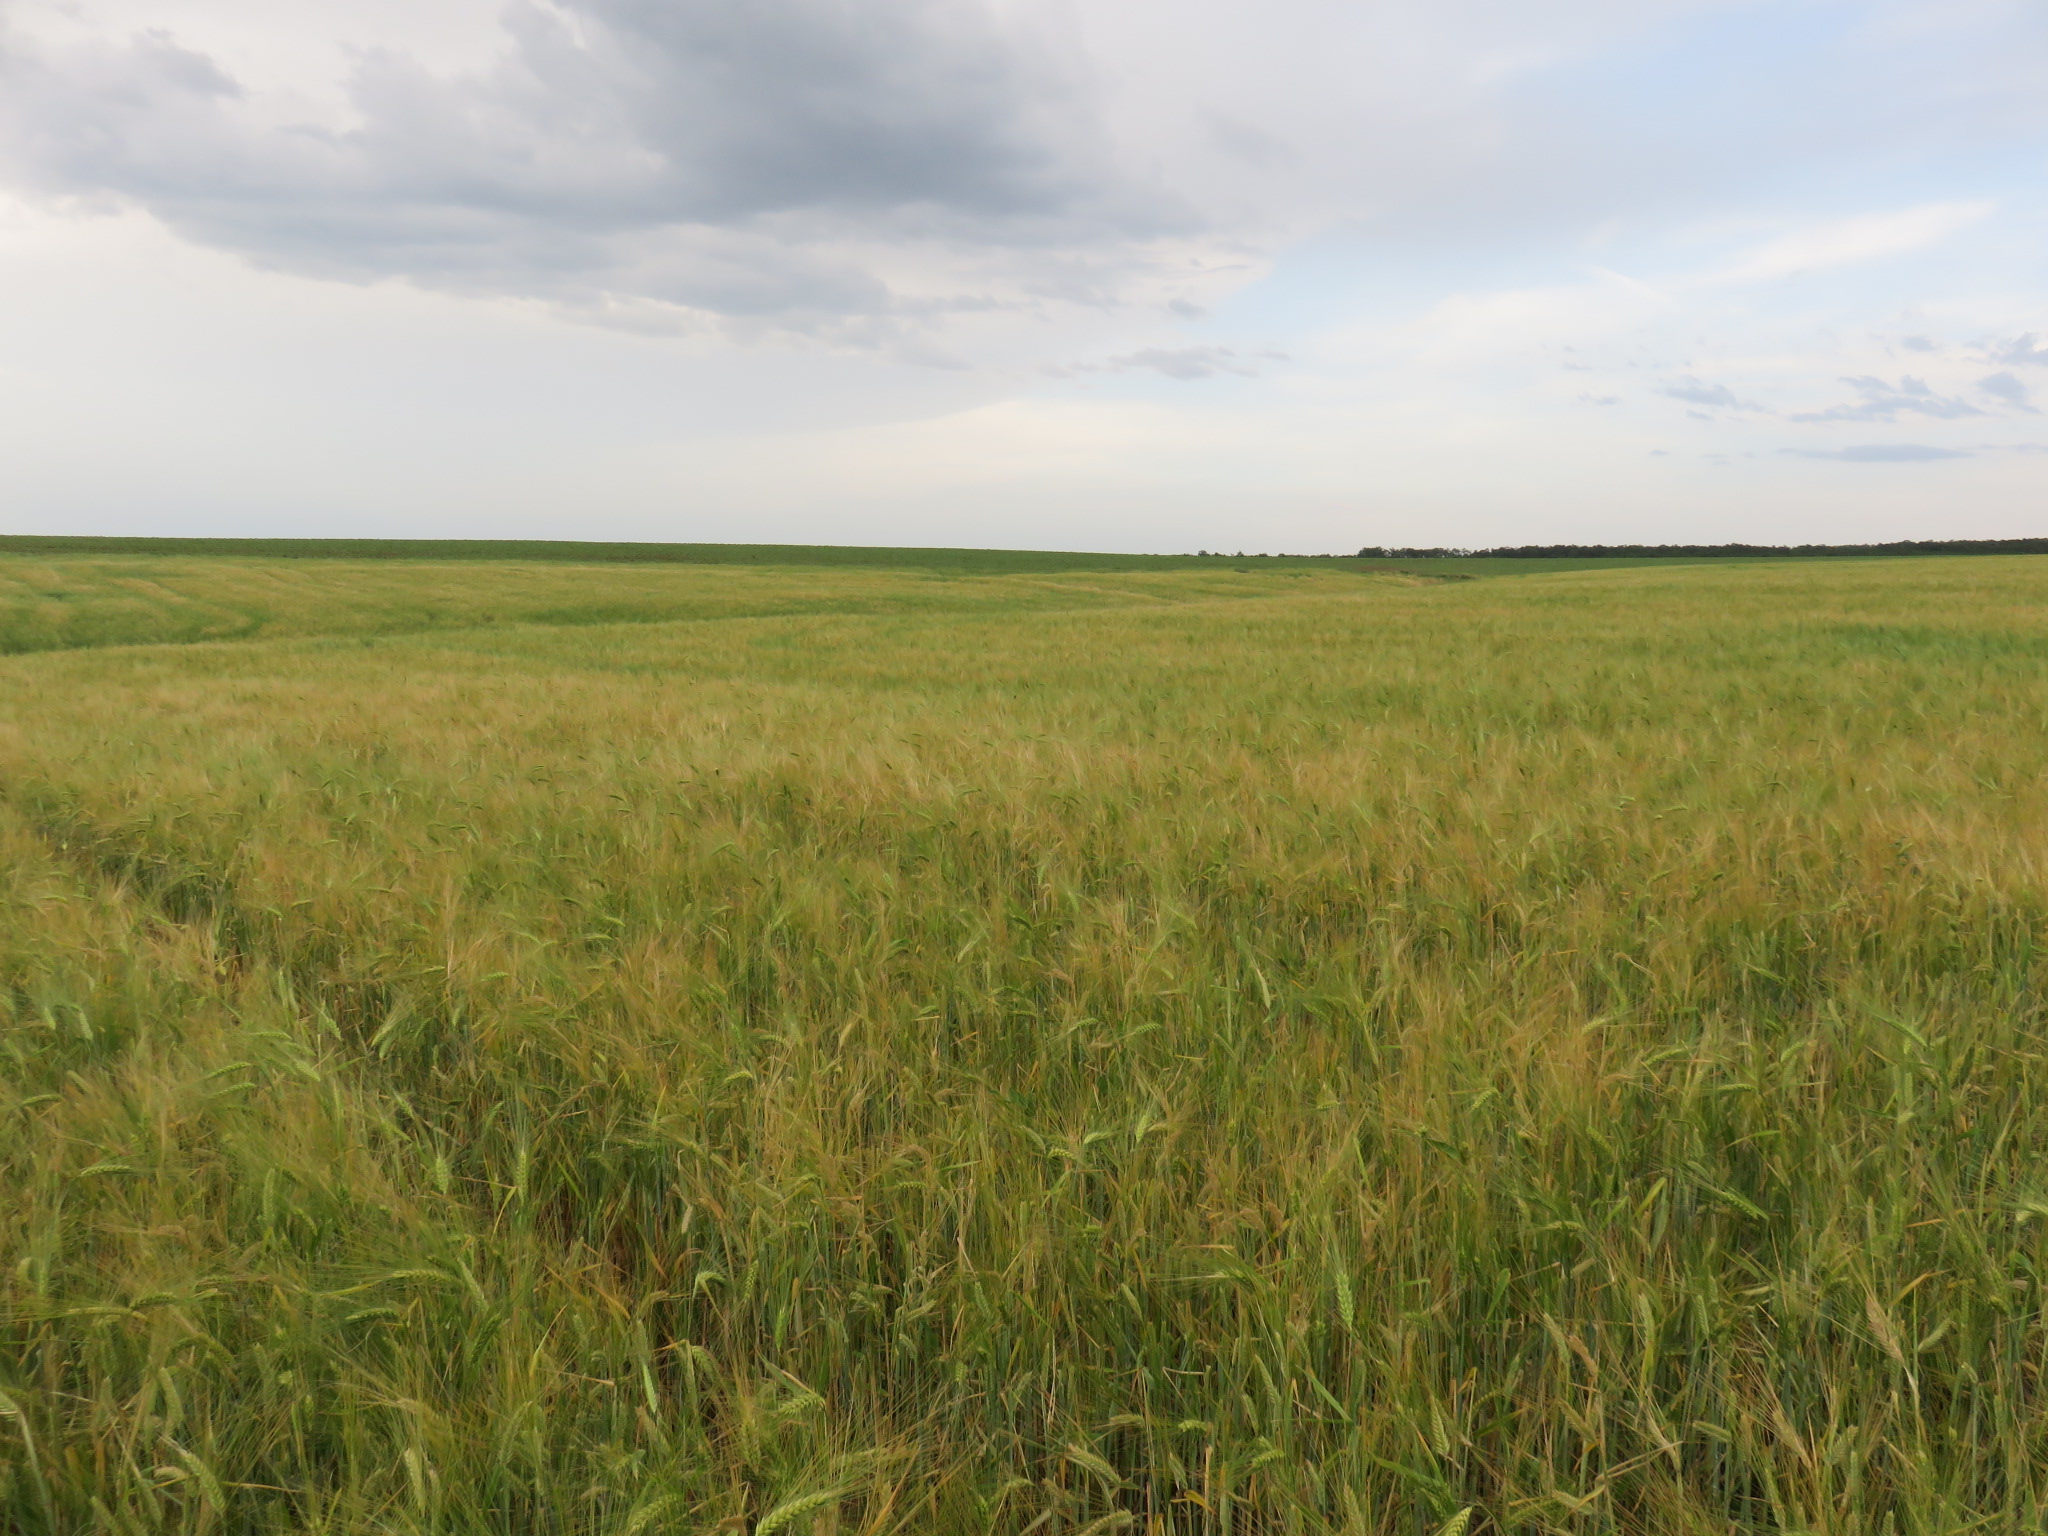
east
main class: Cropland
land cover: Barley
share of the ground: > 75 %
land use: Agriculture (excluding fallow land and kitchen gardens)
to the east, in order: Barley; Grass margins; Sunflower
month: May
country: BG
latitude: 43.3080
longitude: 24.4963
